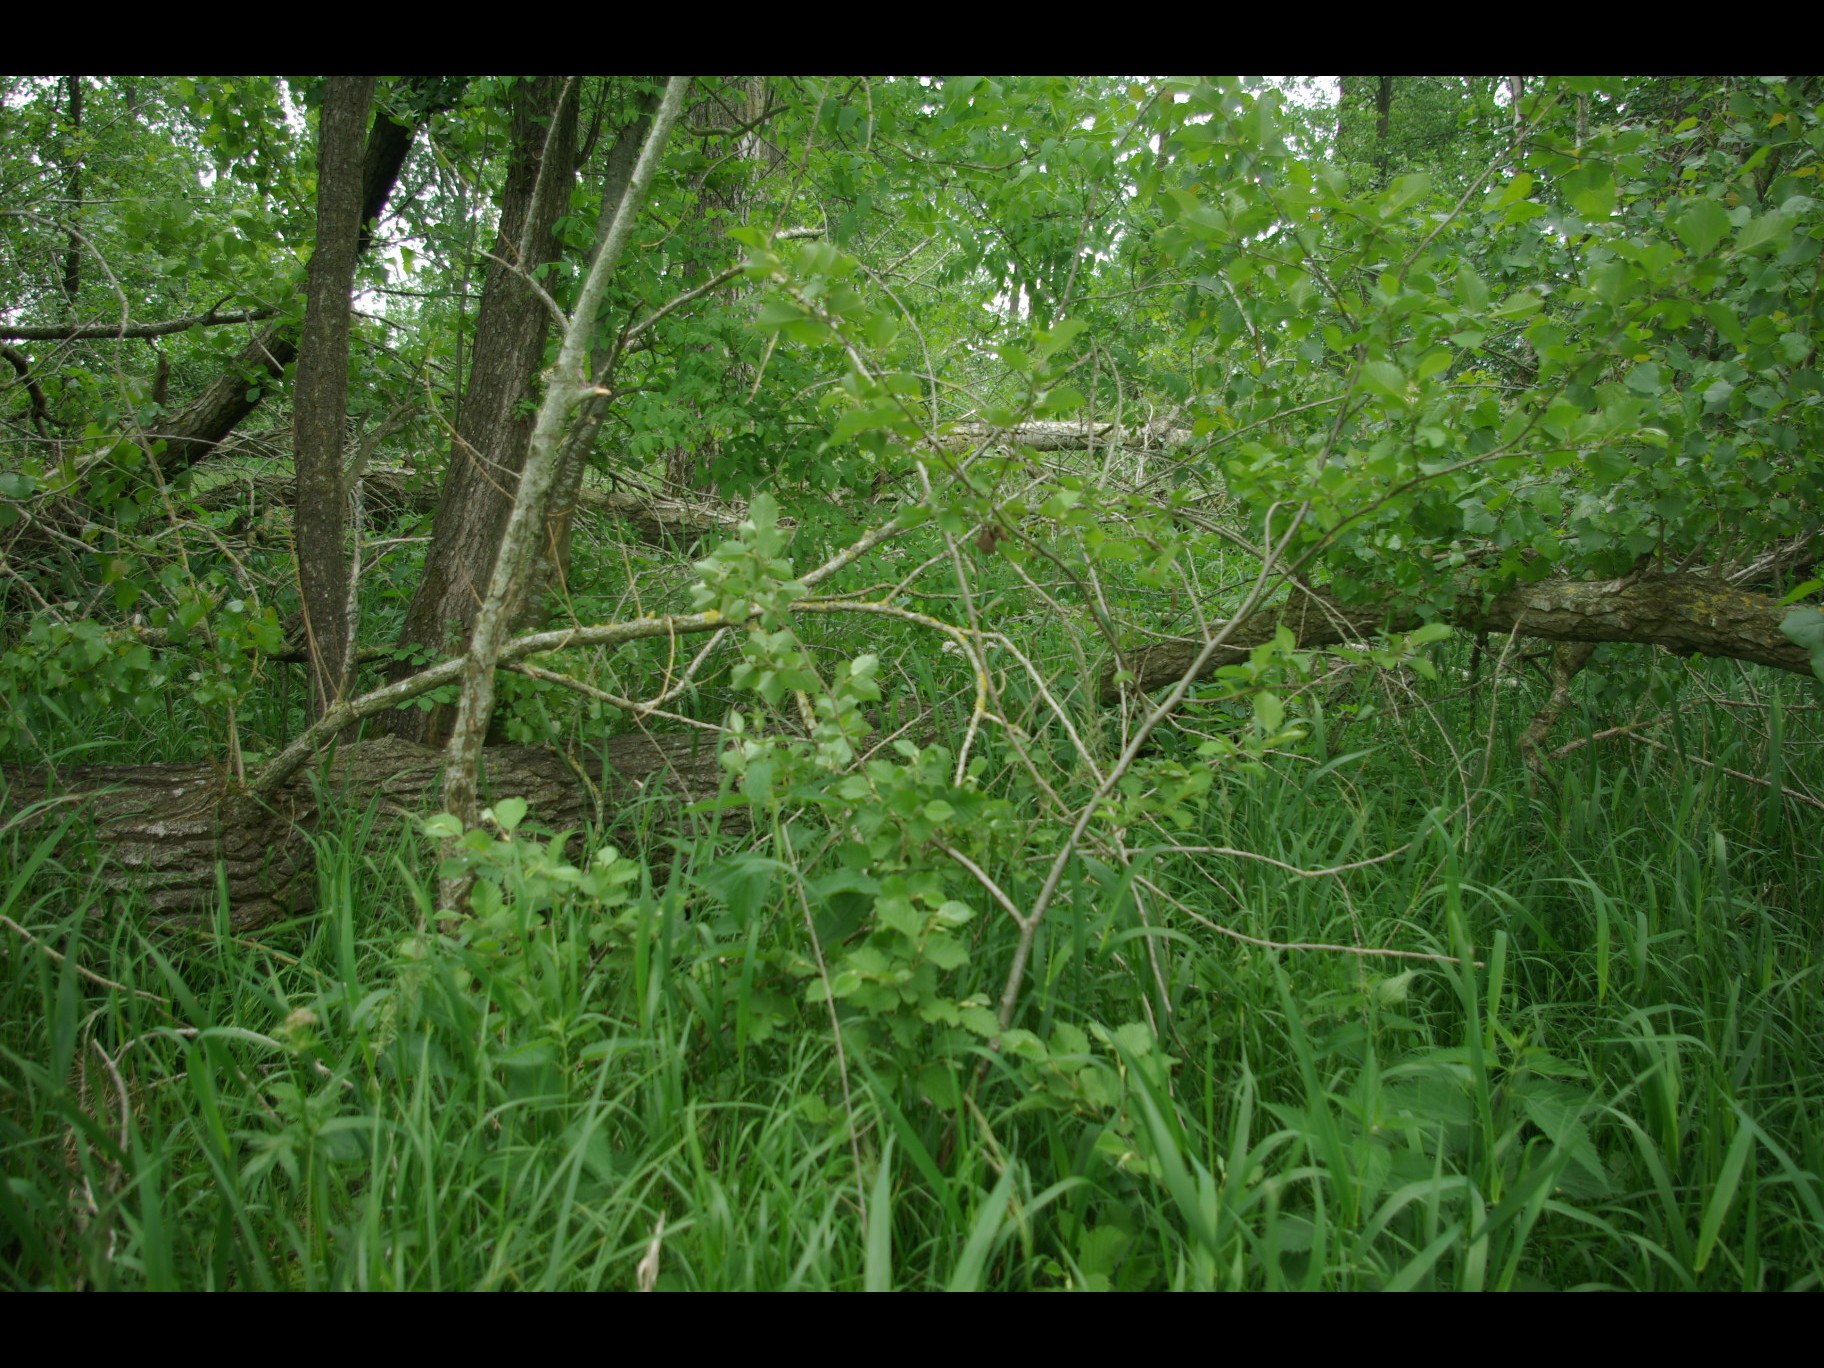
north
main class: Woodland
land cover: Broadleaved woodland
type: mire and swamp forests
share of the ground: 50 - 75 %
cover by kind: broadleaved forest trees 50 %, herbaceous plants 45 %, shrubs 5 %
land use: Semi-natural and natural areas not in use
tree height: > 5 m
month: June
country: DE
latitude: 54.4263
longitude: 9.9230
